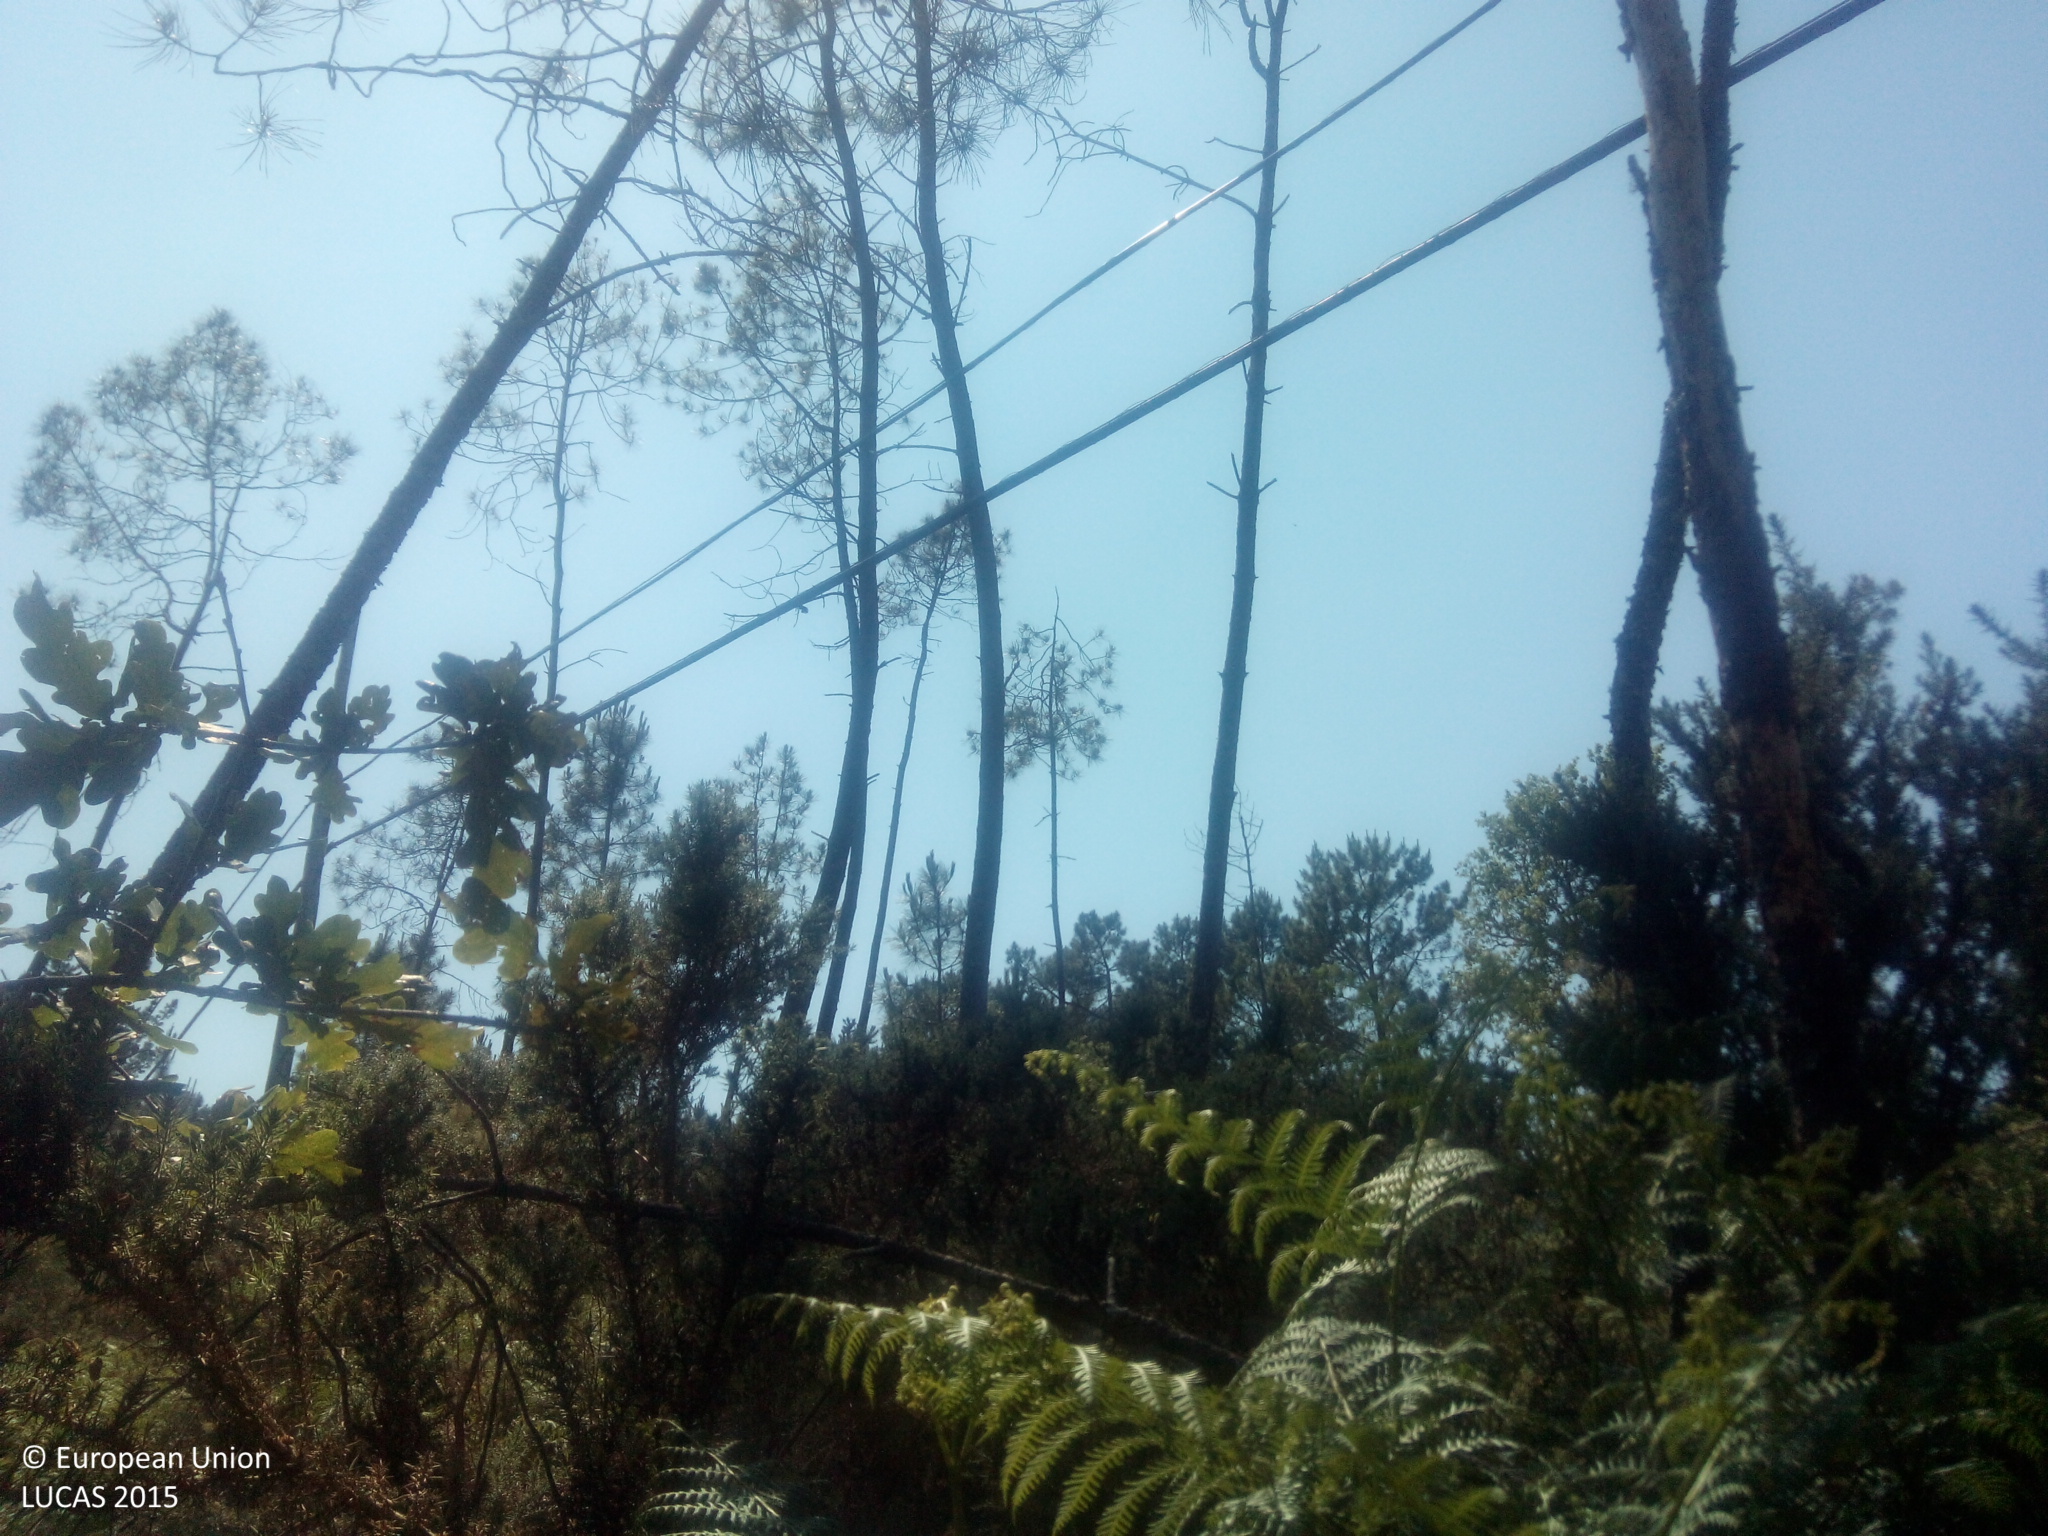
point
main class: Woodland
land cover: Pine dominated coniferous woodland
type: exotic forest
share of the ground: > 75 %
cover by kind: coniferous forest trees 75 %, shrubs 25 %
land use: Forestry
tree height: > 5 m
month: June
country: ES
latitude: 42.2087
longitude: -8.2928
